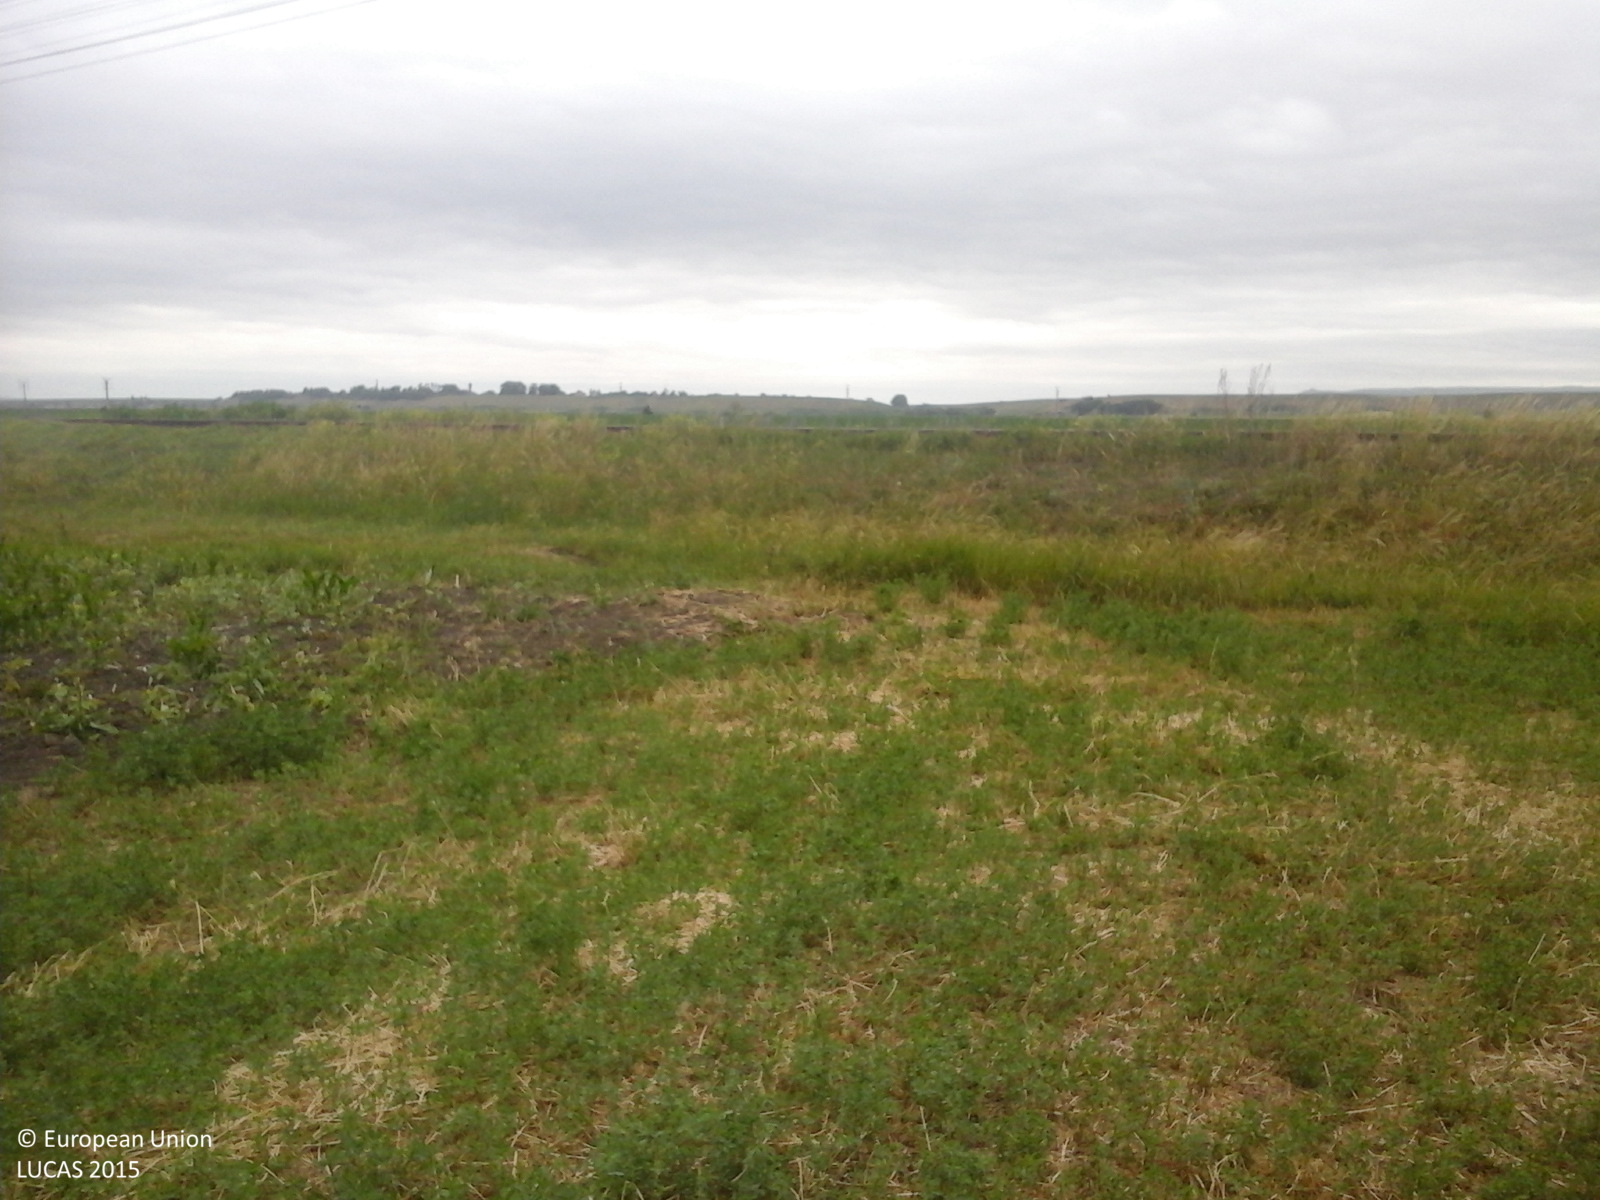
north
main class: Cropland
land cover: Lucerne
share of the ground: > 75 %
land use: Agriculture (excluding fallow land and kitchen gardens)
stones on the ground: < 10 %
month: June
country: RO
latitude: 46.8086
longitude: 26.5851
